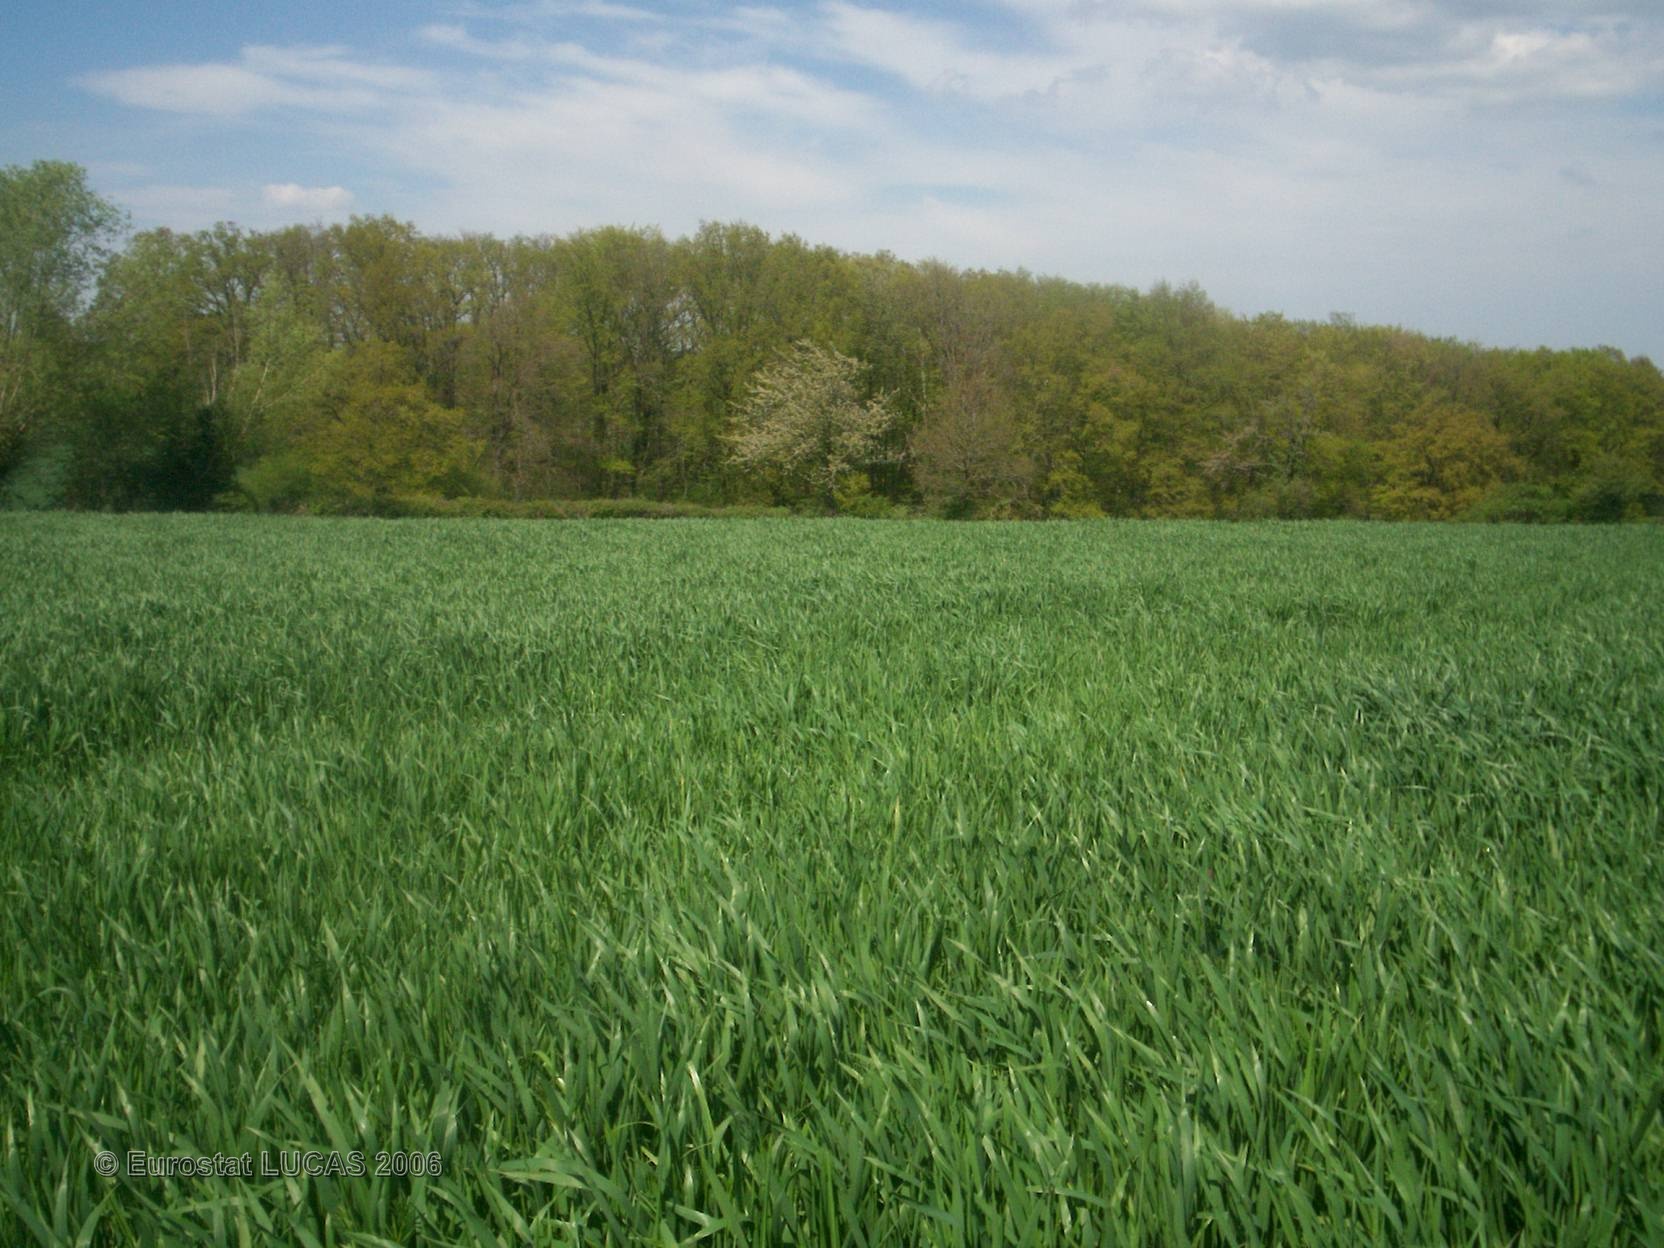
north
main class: Cropland
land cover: Common wheat
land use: Agriculture (excluding fallow land and kitchen gardens)
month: May
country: FR
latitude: 46.1685
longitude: 2.8872
